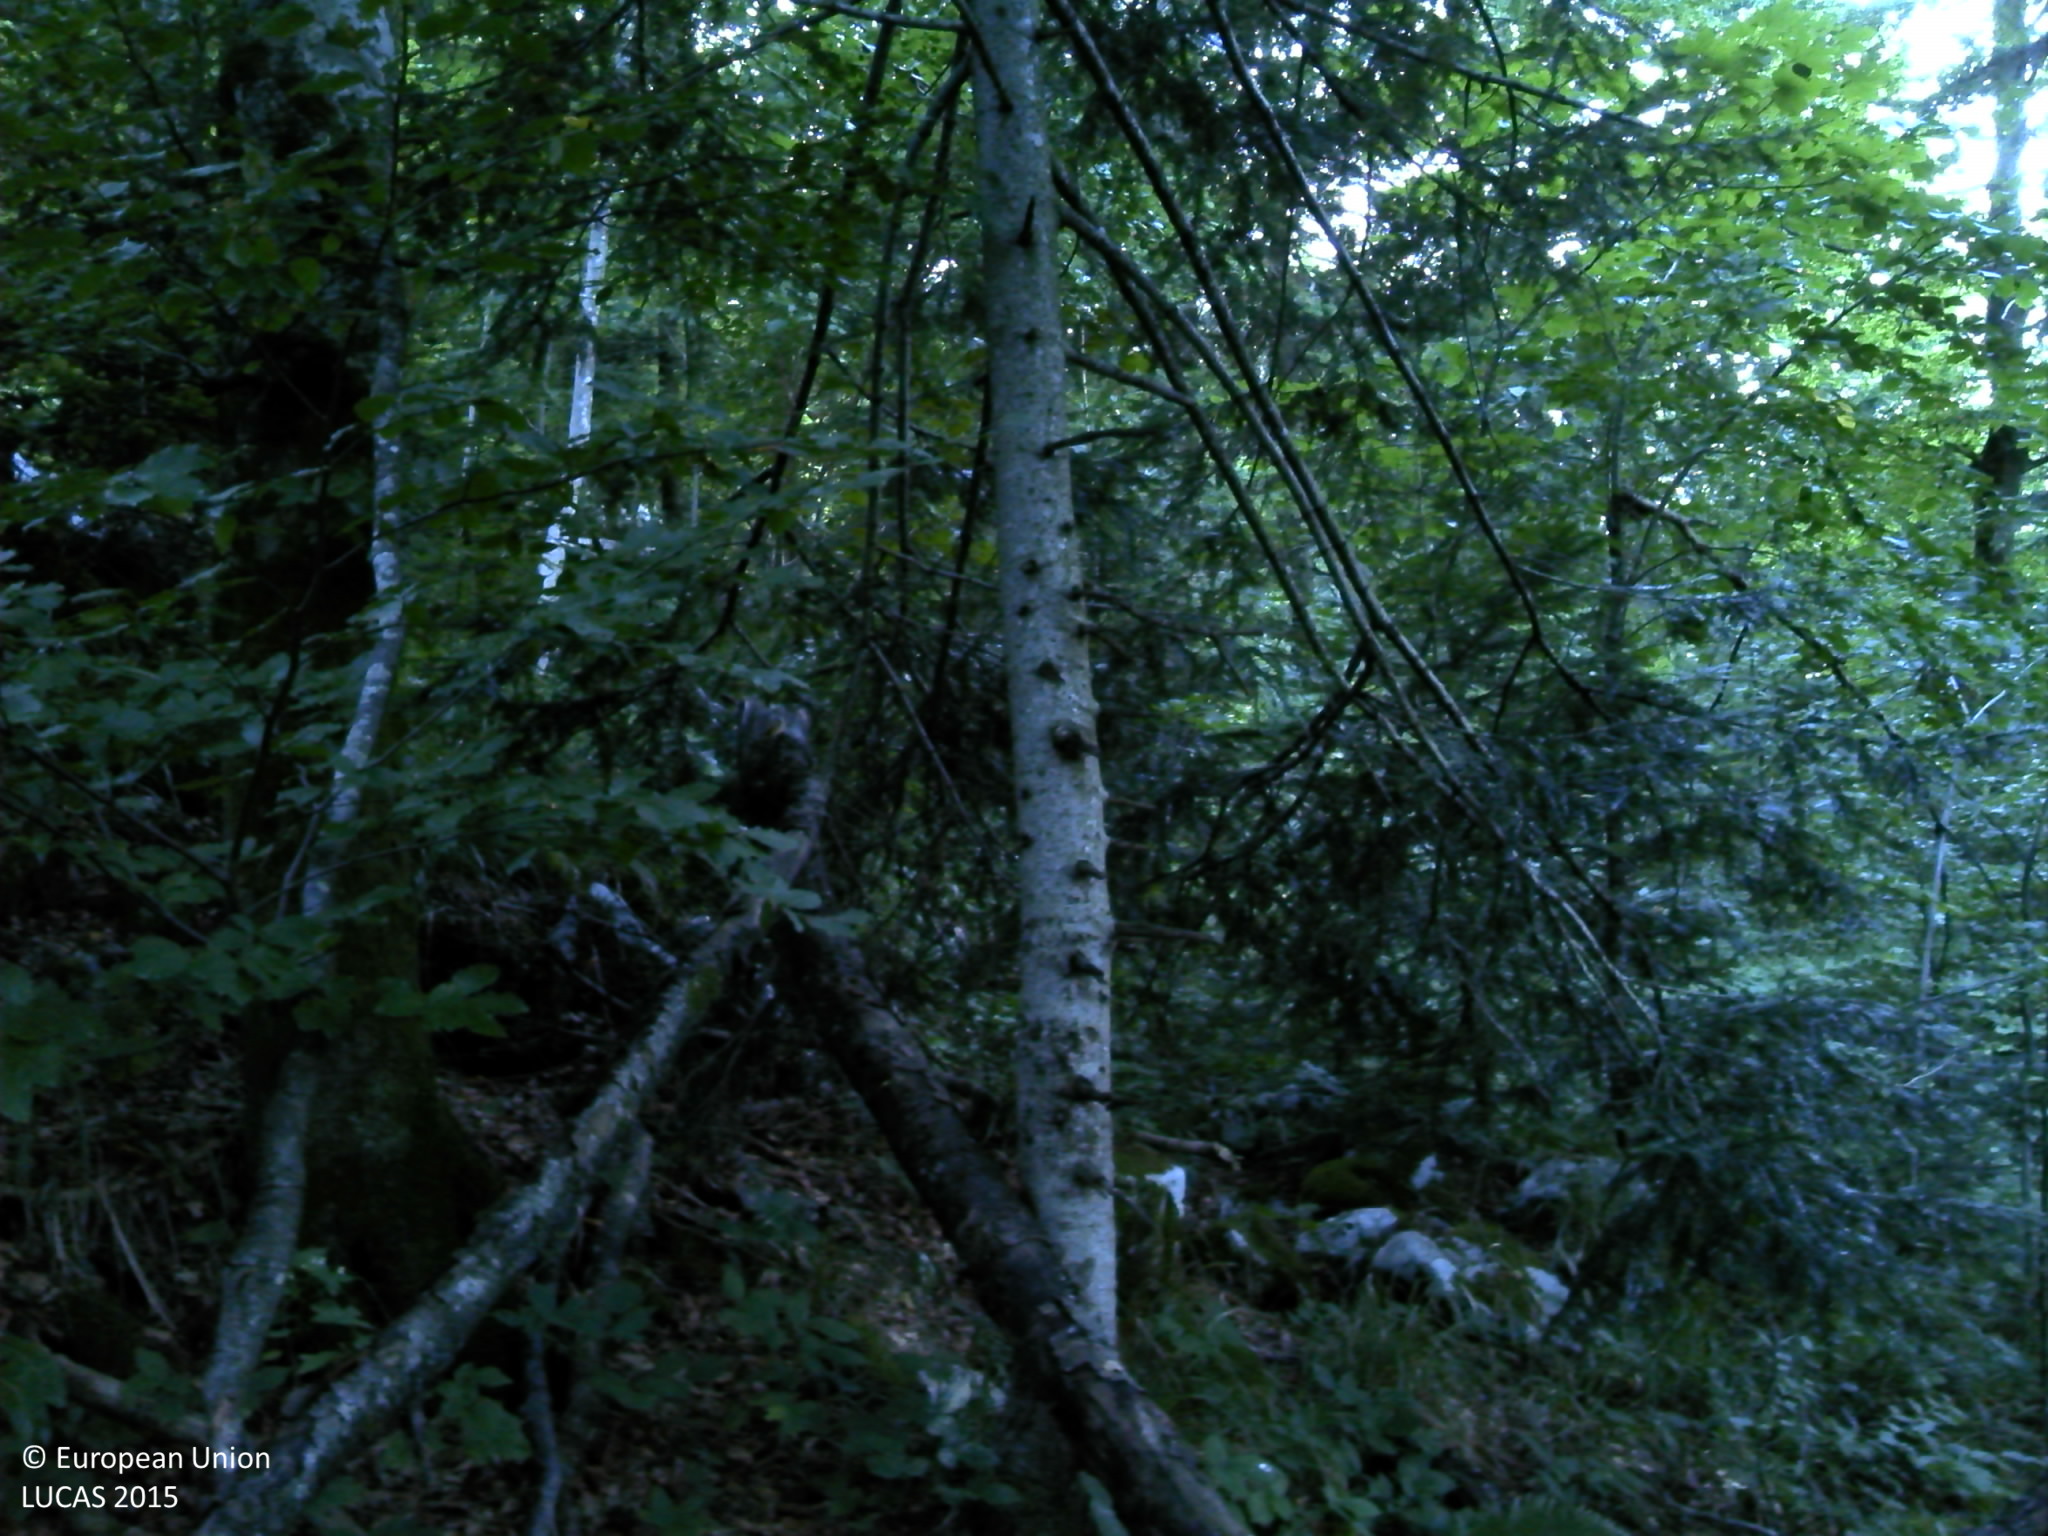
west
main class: Woodland
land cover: Other mixed woodland
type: mountainous beech forest
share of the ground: > 75 %
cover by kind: broadleaved forest trees 60 %, coniferous forest trees 30 %, herbaceous plants 5 %, unconsolidated bare surface 5 %
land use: Forestry
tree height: > 5 m
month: August
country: HR
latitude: 45.0952
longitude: 15.0393
